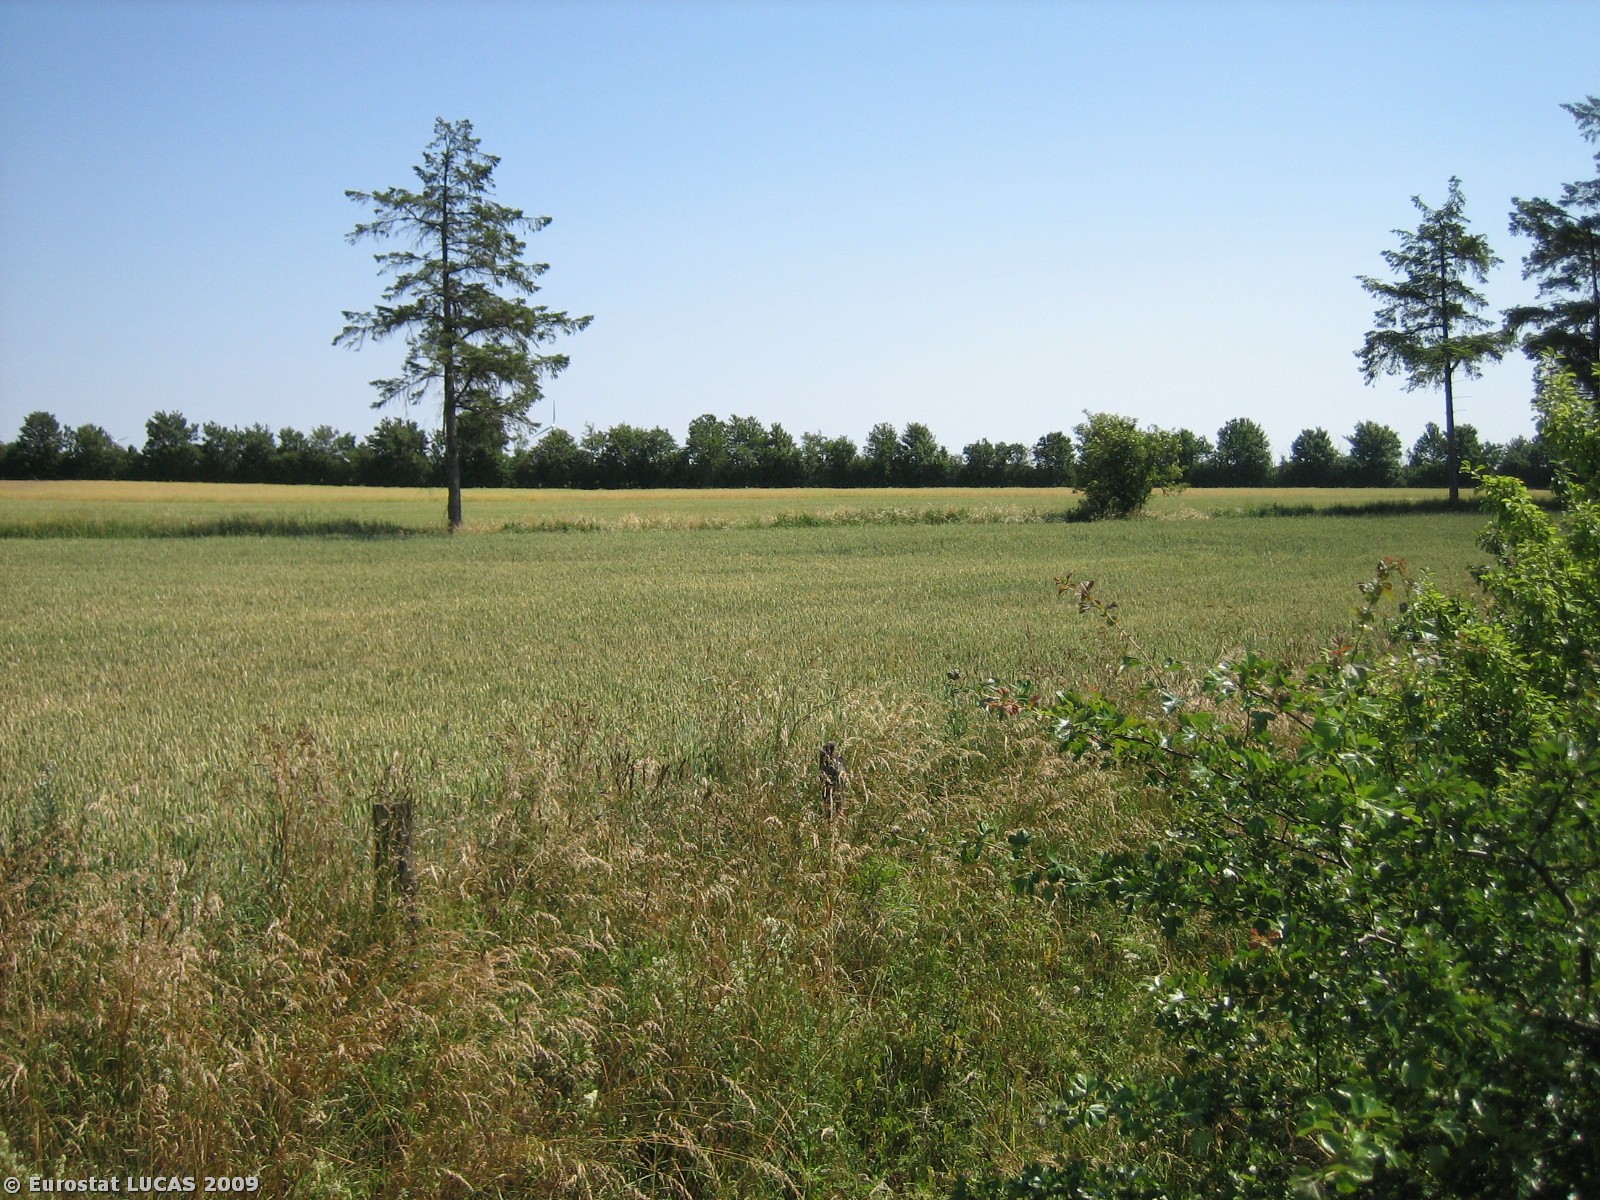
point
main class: Cropland
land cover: Common wheat
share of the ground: > 75 %
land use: Agriculture (excluding fallow land and kitchen gardens)
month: July
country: DK
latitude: 55.3050
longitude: 9.2918
